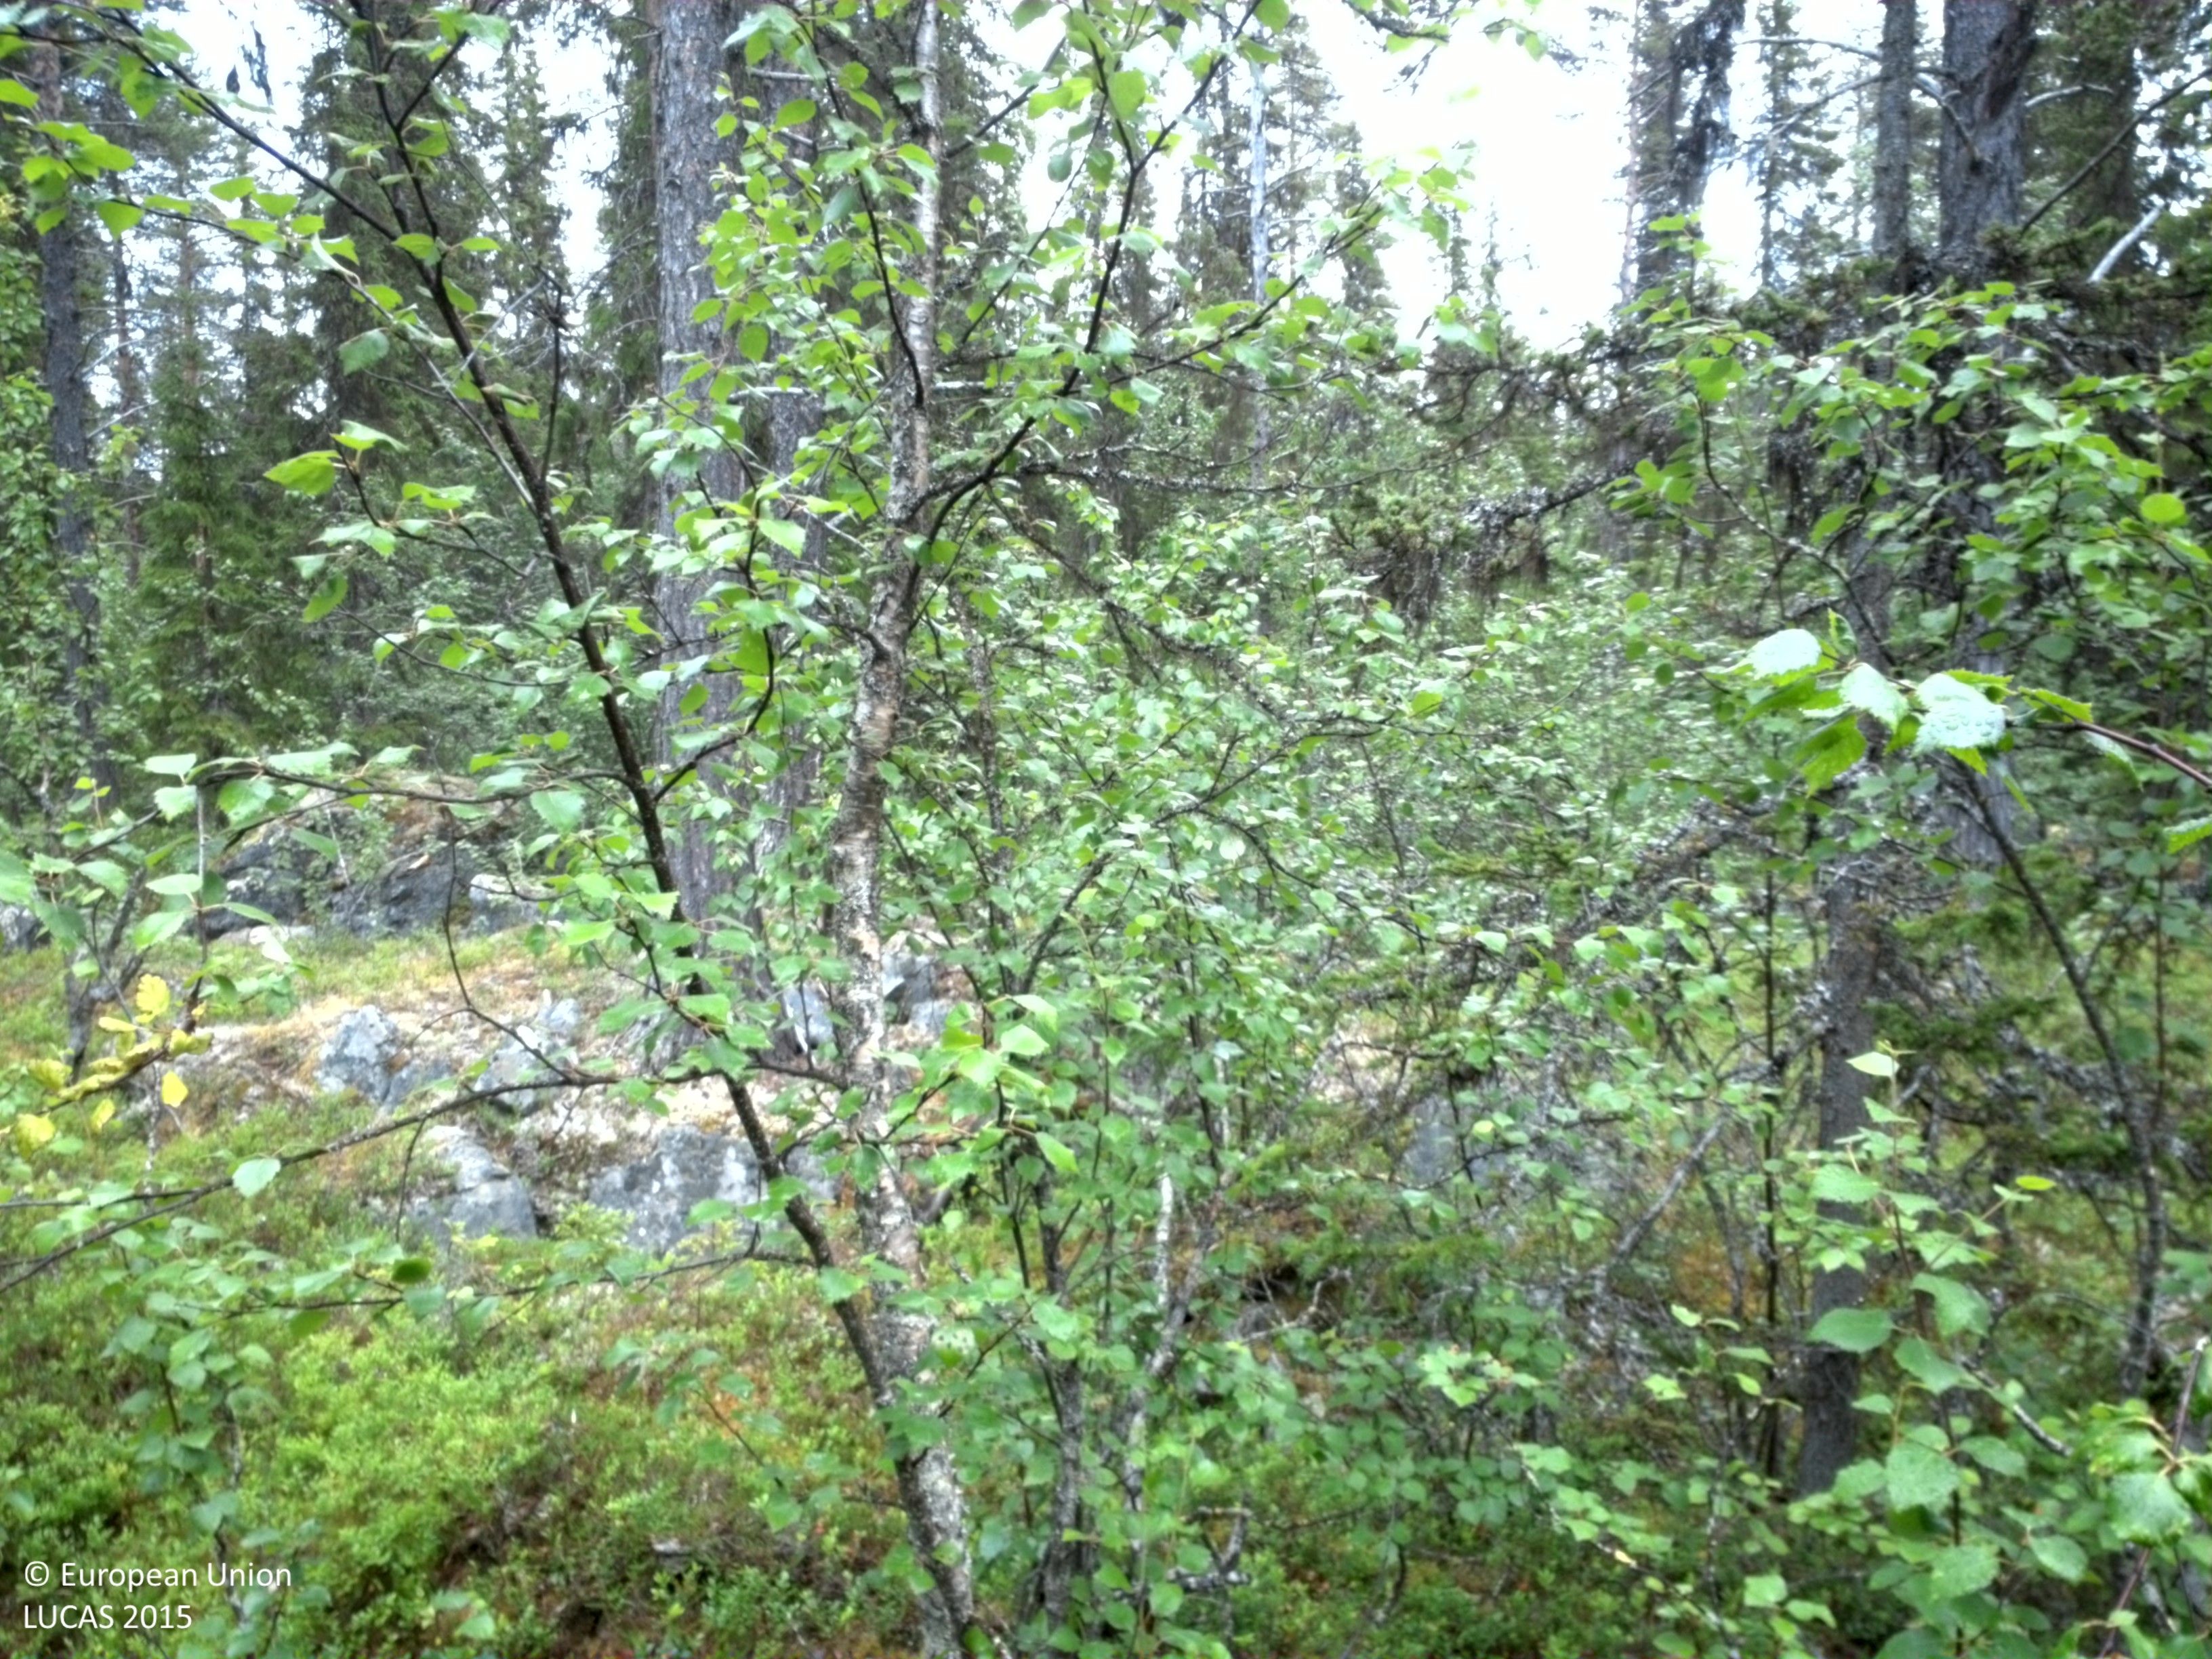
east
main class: Woodland
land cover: Pine dominated mixed woodland
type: boreal forest
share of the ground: 25 - 50 %
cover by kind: shrubs 40 %, broadleaved forest trees 25 %, lichens and mosses 20 %, coniferous forest trees 15 %
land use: Forestry
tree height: > 5 m
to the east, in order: Pine dominated mixed woodland; Spruce dominated coniferous woodland; Shrubland with sparse tree cover; Tracks; Shrubland with sparse tree cover; Pine dominated coniferous woodland; Other coniferous woodland; Spruce dominated coniferous woodland
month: August
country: SE
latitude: 65.0403
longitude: 16.1457
